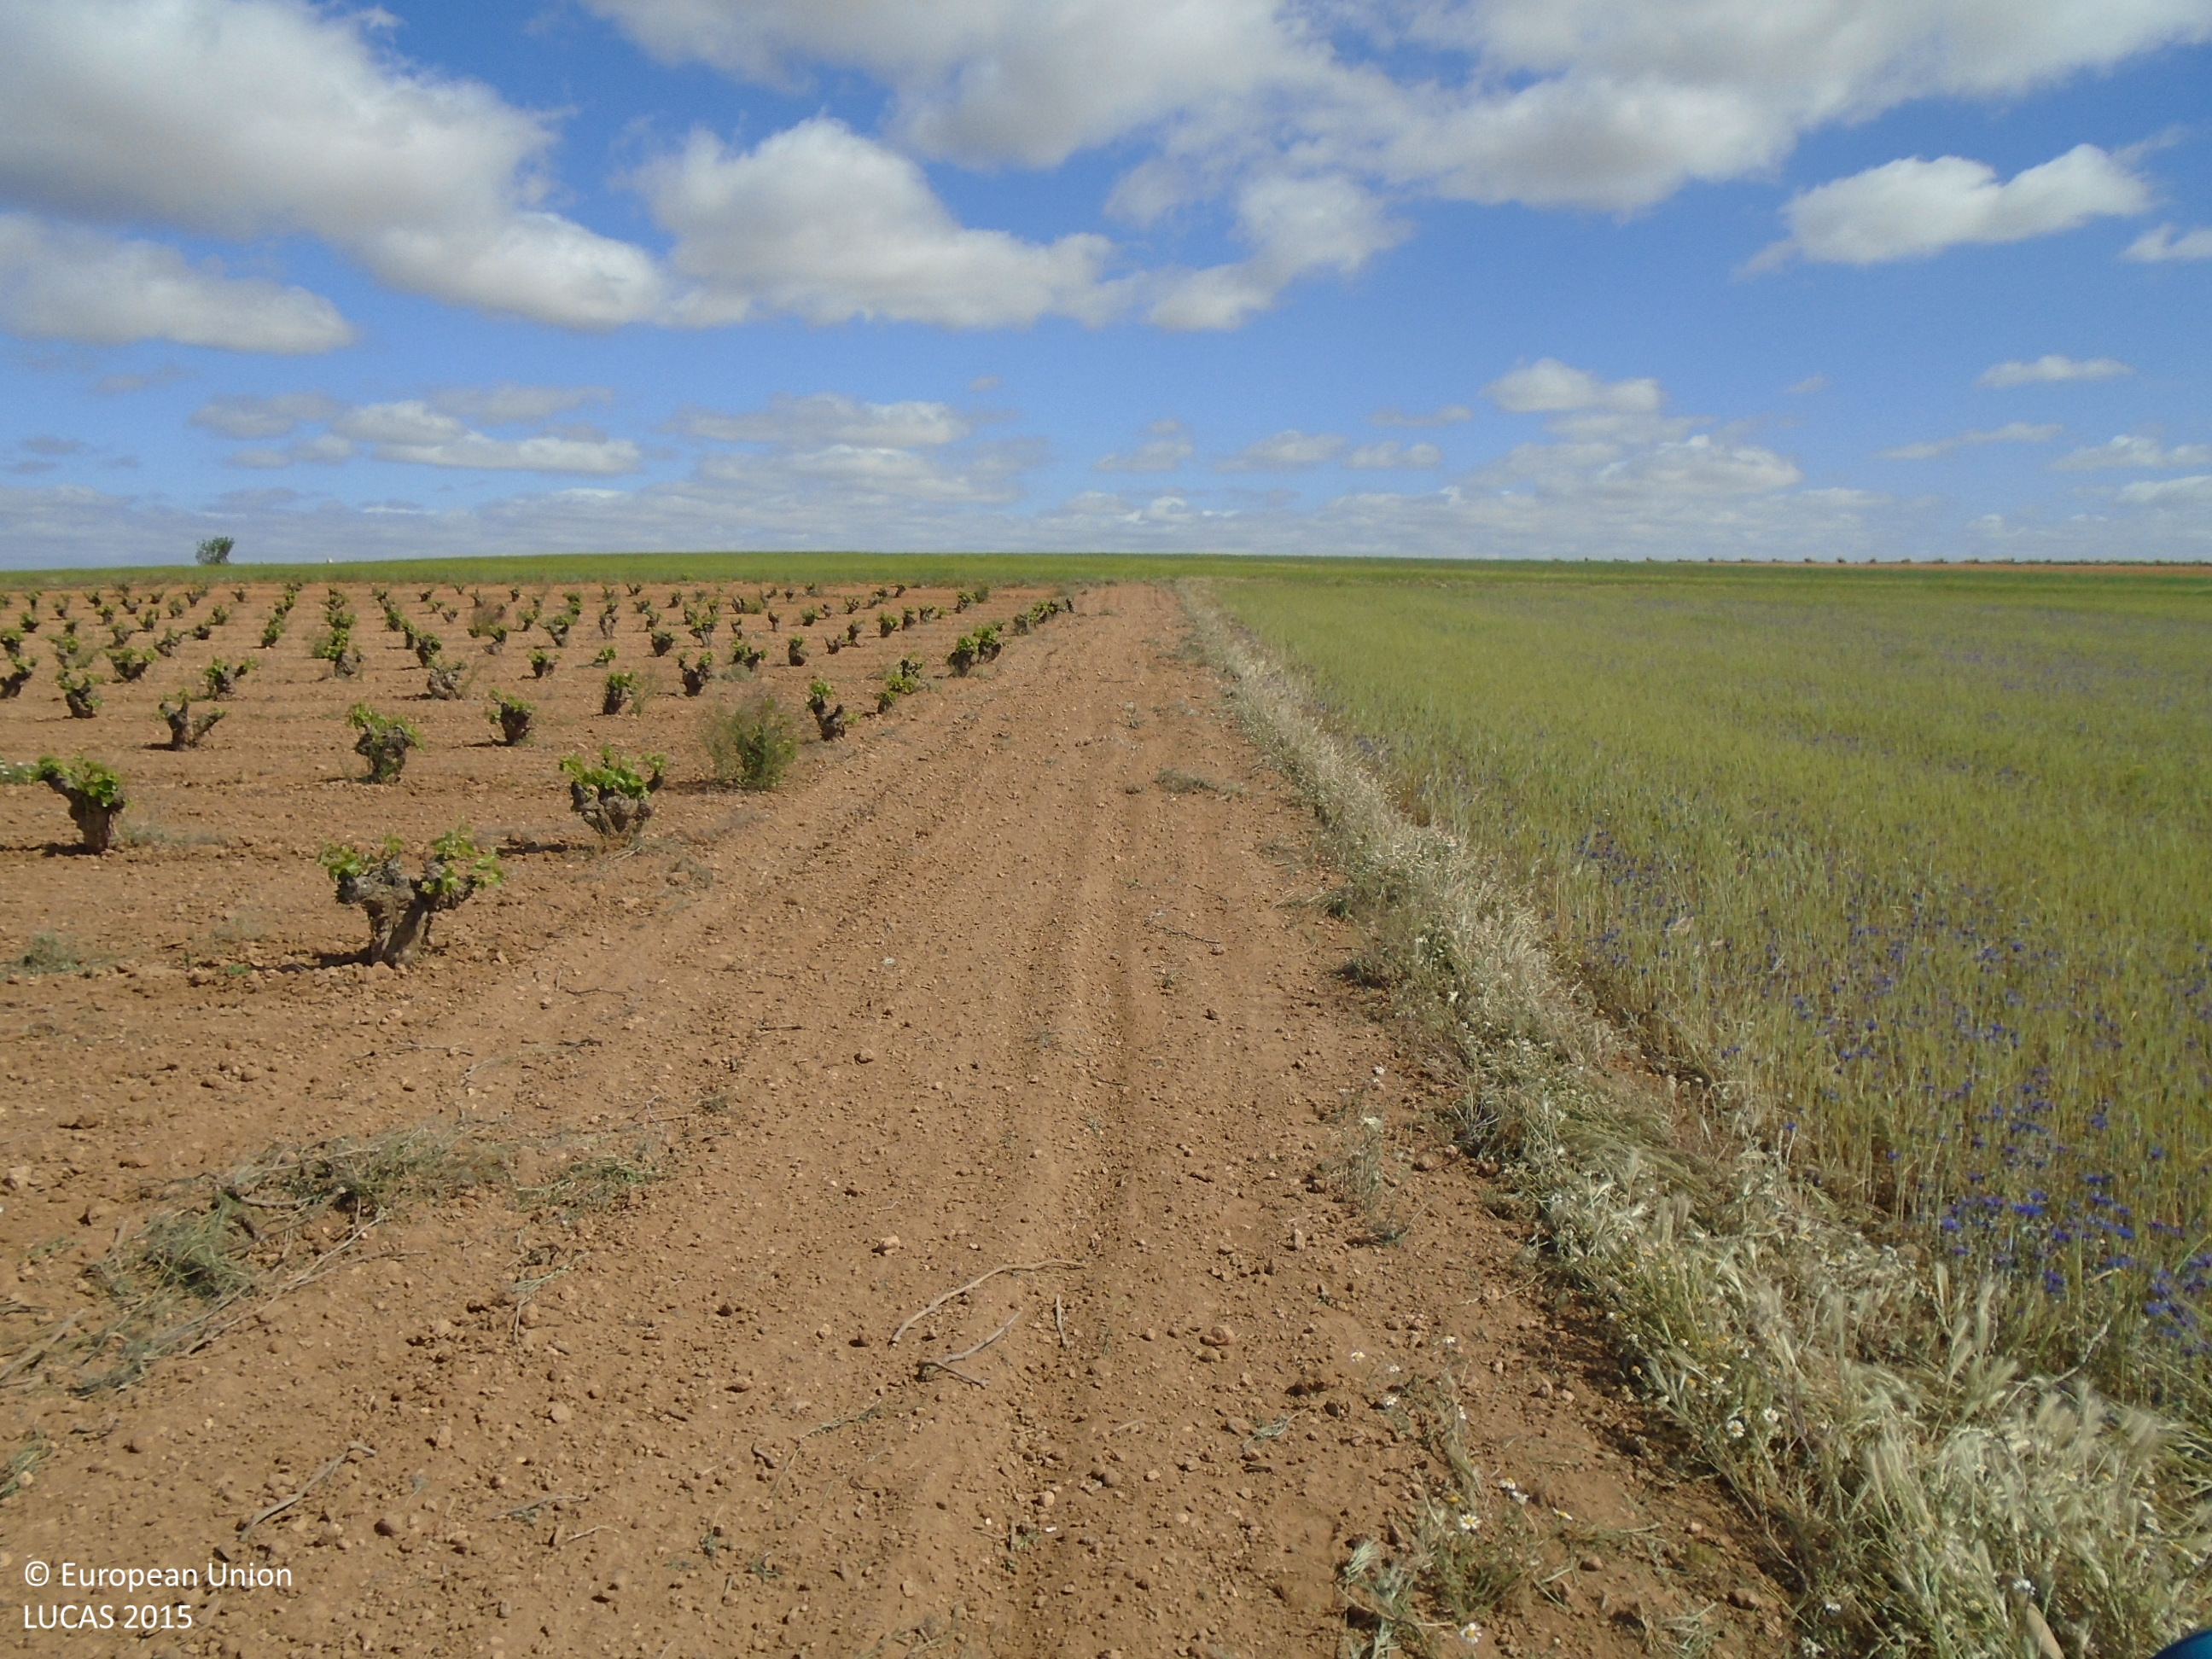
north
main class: Cropland
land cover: Vineyards
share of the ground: 10 - 25 %
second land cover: Other bare soil
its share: > 75 %
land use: Agriculture (excluding fallow land and kitchen gardens)
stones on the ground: < 10 %
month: May
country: ES
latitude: 39.5592
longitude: -3.5602
